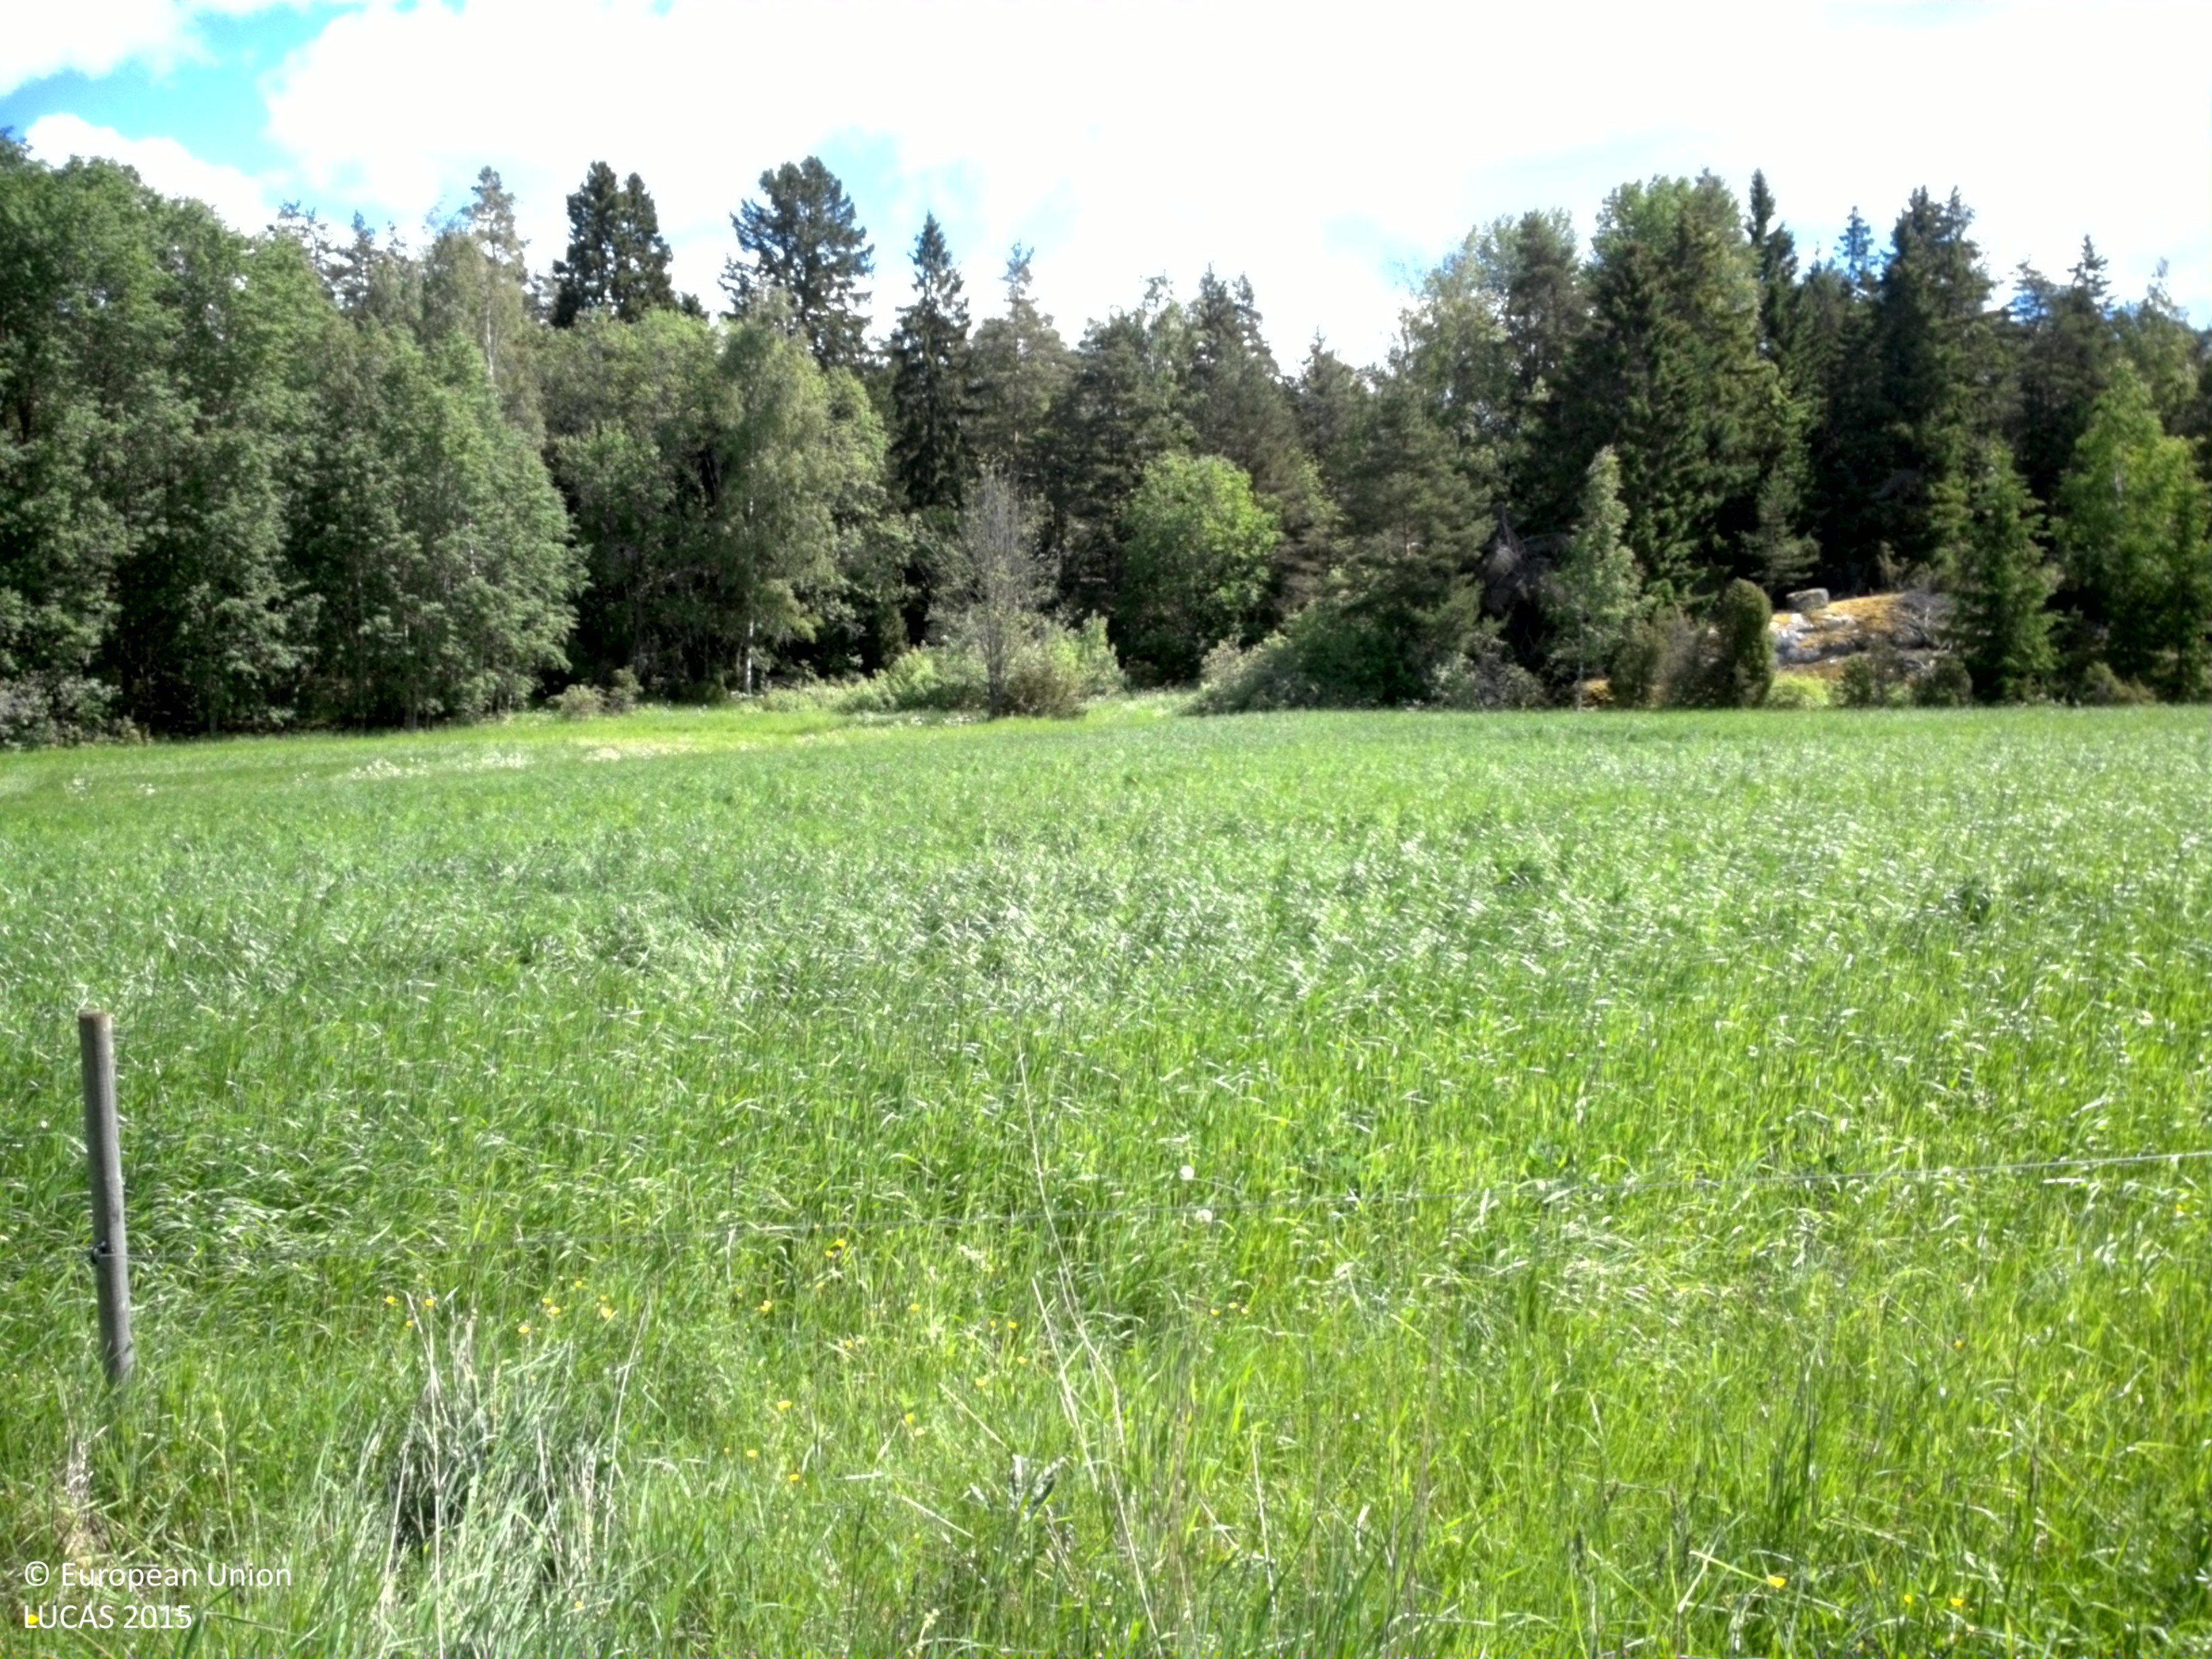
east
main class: Grassland
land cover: Grassland with sparse tree/shrub cover
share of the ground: > 75 %
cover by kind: herbaceous plants 90 %, coniferous forest trees 5 %, shrubs 5 %
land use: Agriculture (excluding fallow land and kitchen gardens)
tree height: > 5 m
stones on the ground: < 10 %
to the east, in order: Grassland with sparse tree/shrub cover; Fences; Other leguminous and mixtures for fodder; Grassland with sparse tree/shrub cover; Tracks; Spruce dominated mixed woodland; Pine dominated mixed woodland; Ditches and canals; Other leguminous and mixtures for fodder
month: June
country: SE
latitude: 59.9452
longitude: 17.4938
